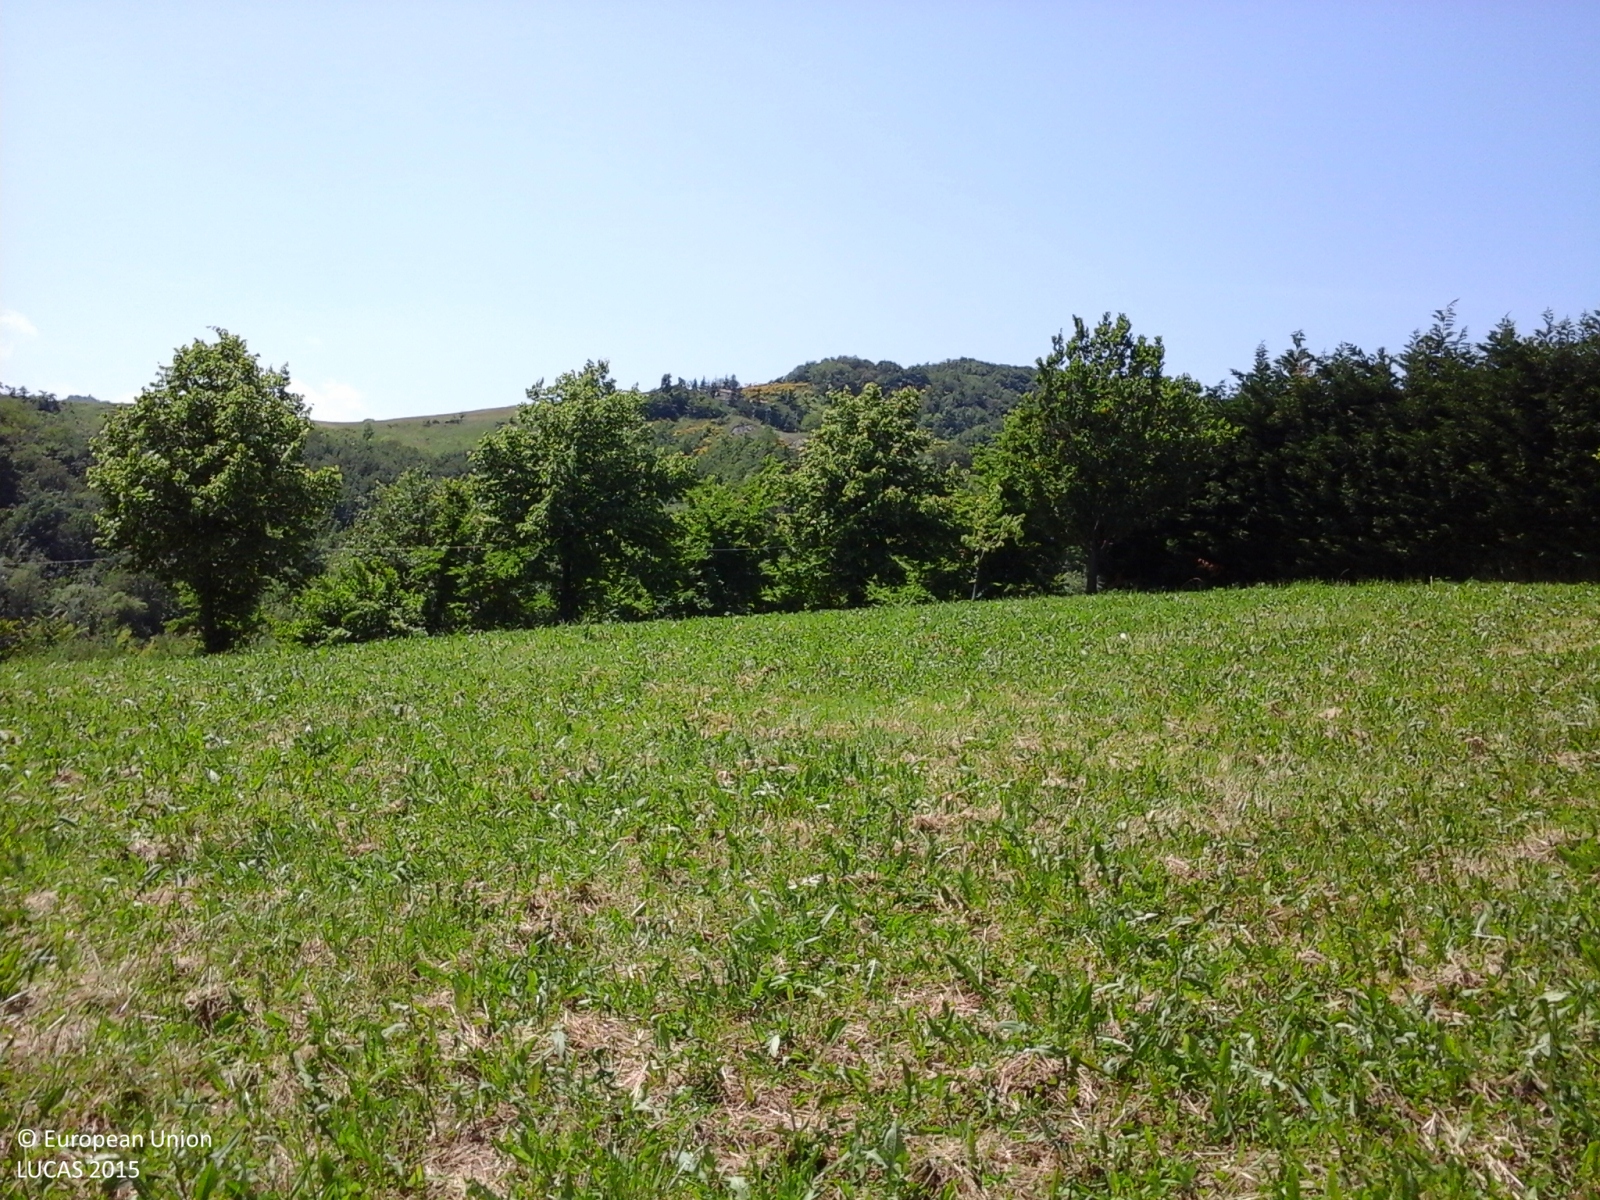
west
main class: Grassland
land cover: Grassland with sparse tree/shrub cover
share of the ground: > 75 %
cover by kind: herbaceous plants 95 %, broadleaved forest trees 5 %
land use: Residential
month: May
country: IT
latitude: 44.7653
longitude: 9.9622
